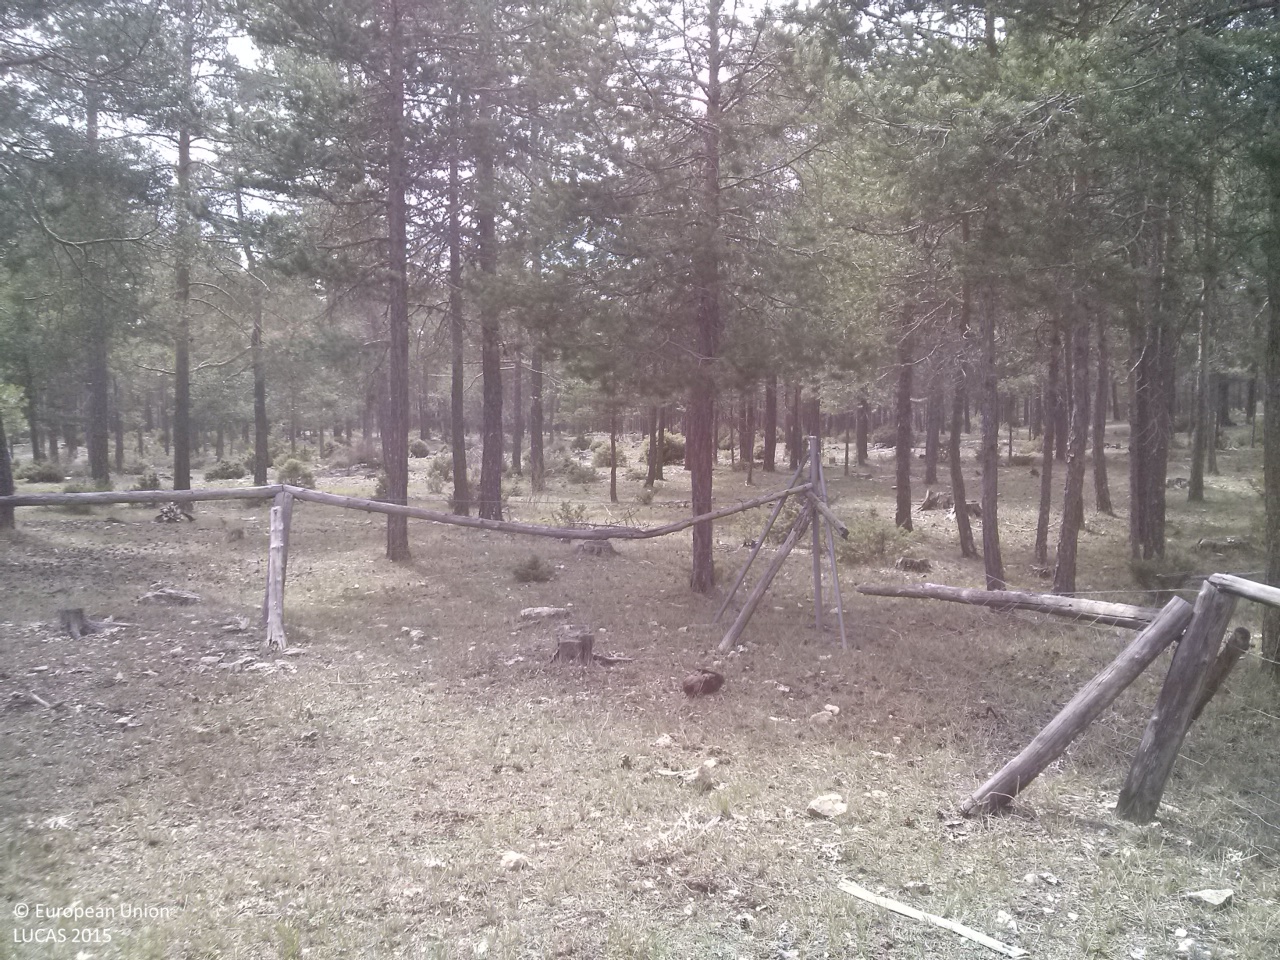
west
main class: Woodland
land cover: Pine dominated coniferous woodland
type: coniferous forest of the mediterranean region
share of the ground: 50 - 75 %
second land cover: Grassland without tree/shrub cover
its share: > 75 %
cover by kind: coniferous forest trees 50 %, herbaceous plants 50 %
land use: Forestry
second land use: Agriculture (excluding fallow land and kitchen gardens)
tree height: > 5 m
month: April
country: ES
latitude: 40.2882
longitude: -1.9085
